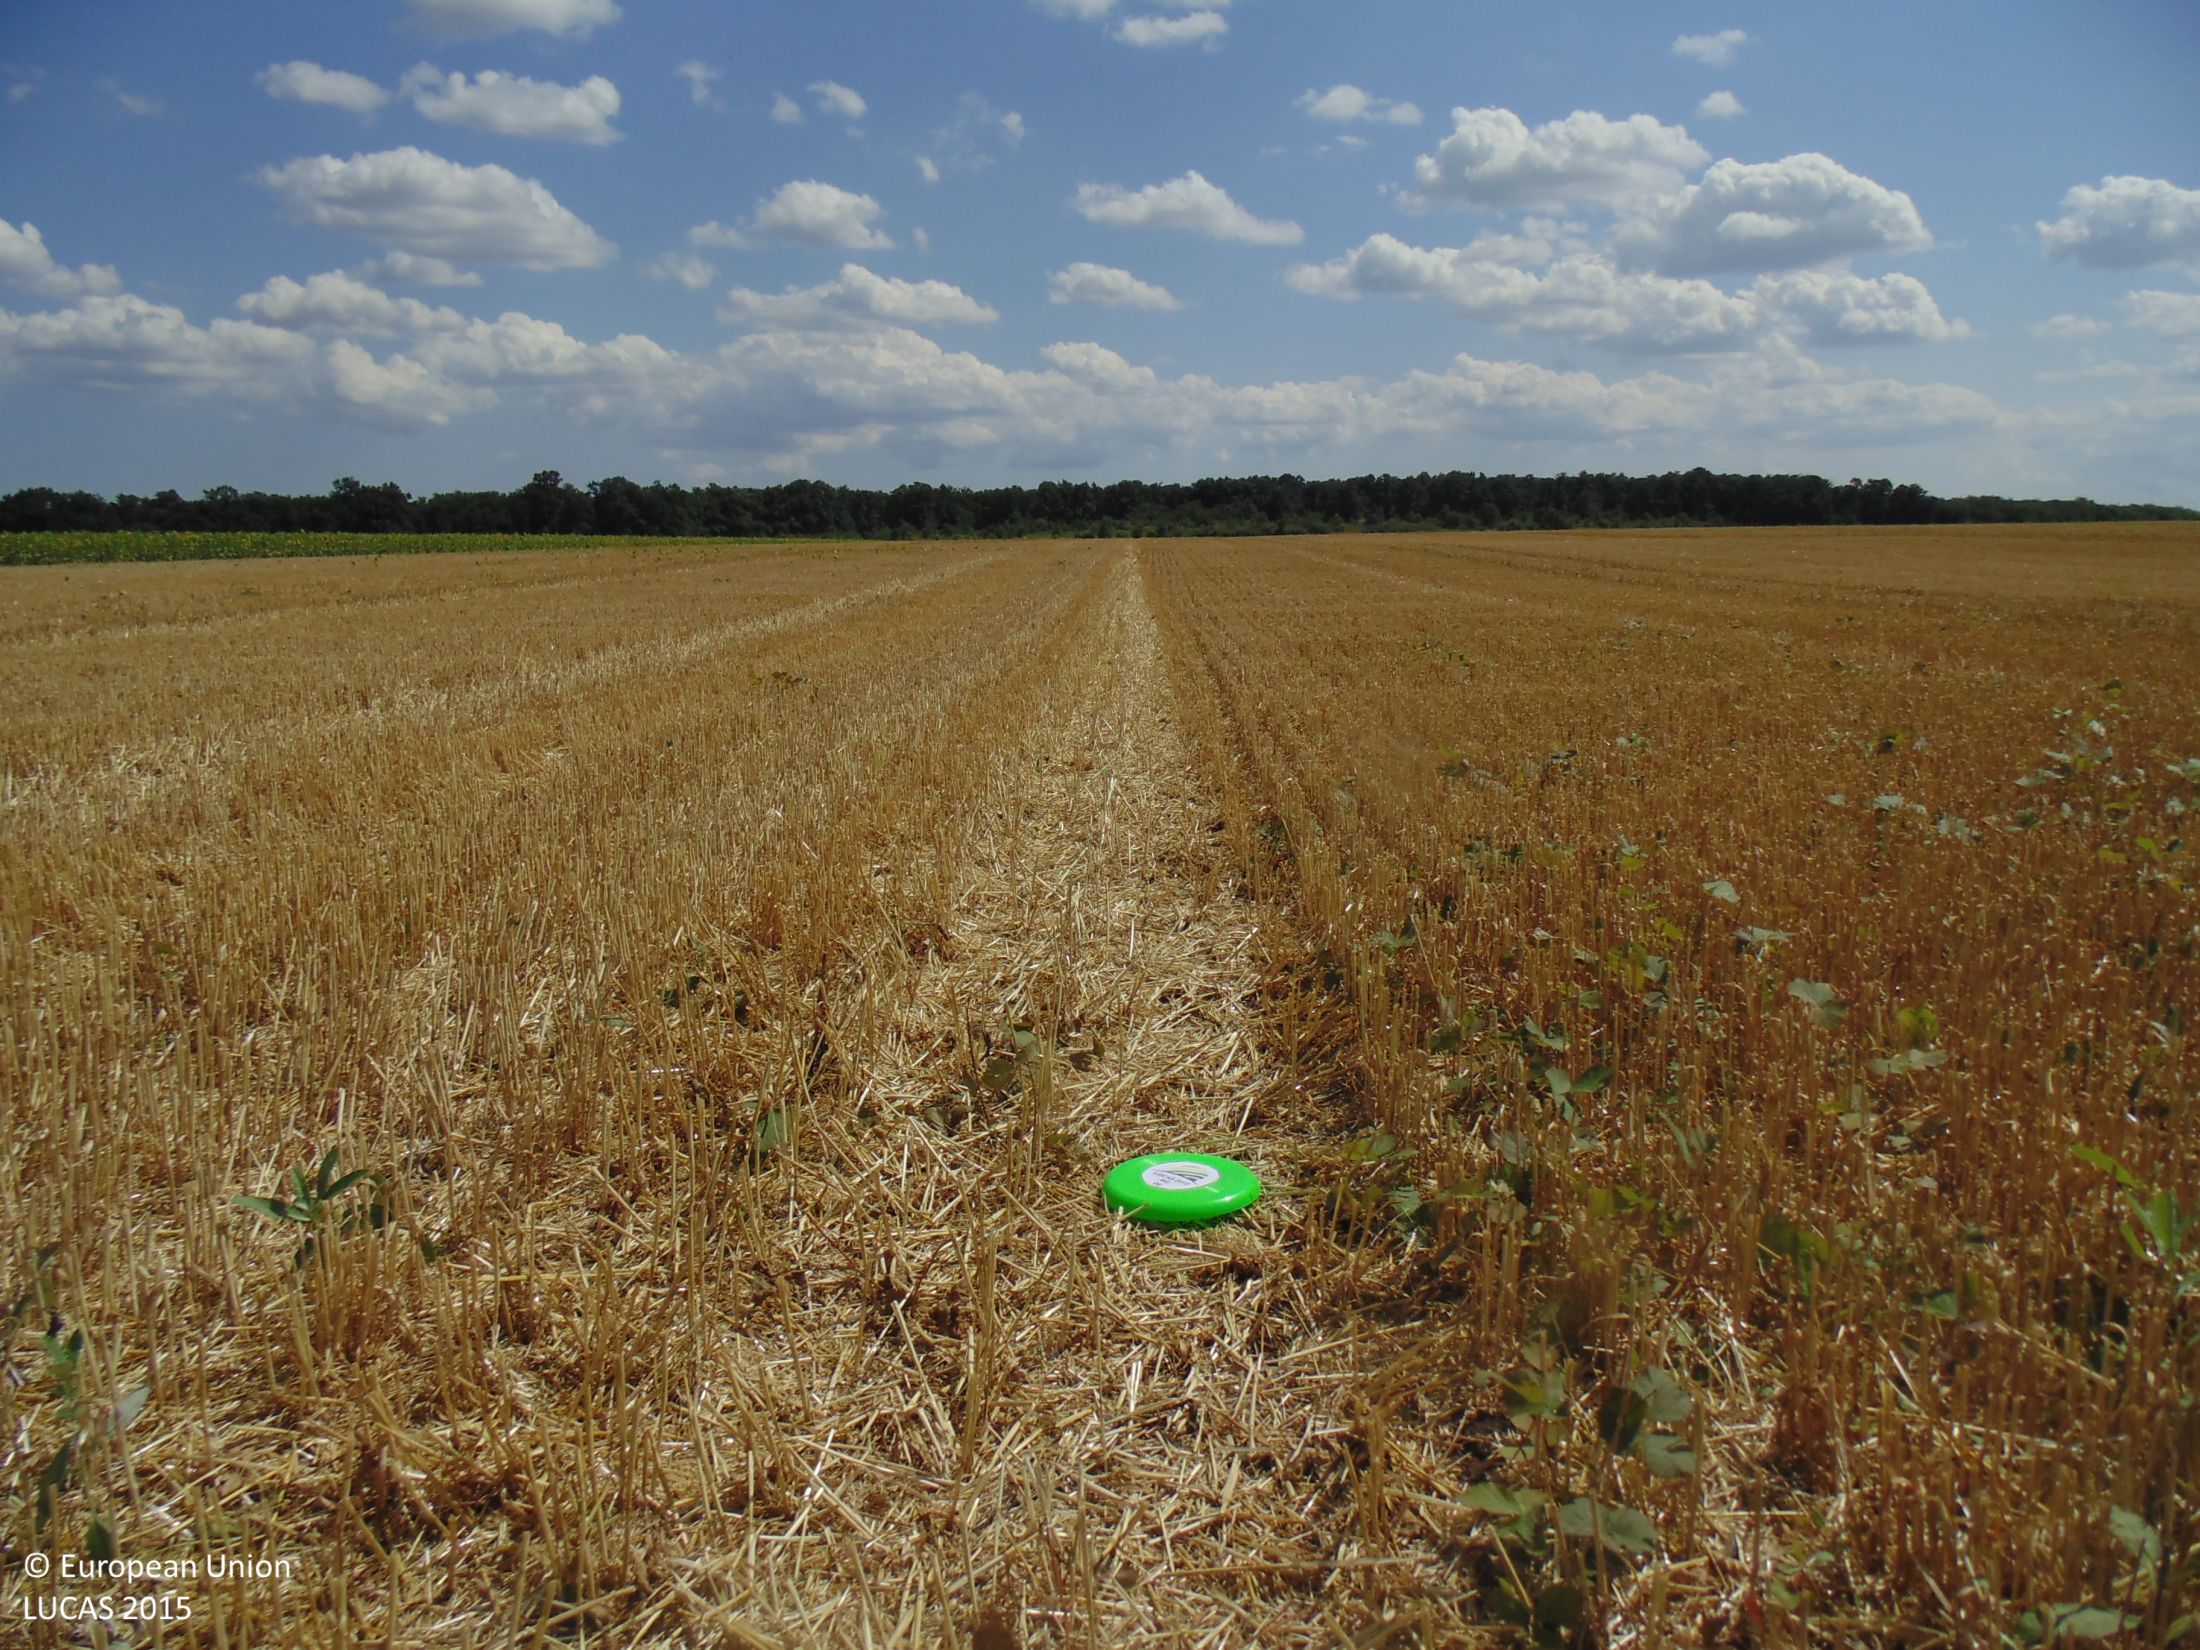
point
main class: Cropland
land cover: Common wheat
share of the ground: > 75 %
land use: Agriculture (excluding fallow land and kitchen gardens)
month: July
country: BG
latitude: 43.5685
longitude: 27.7071
